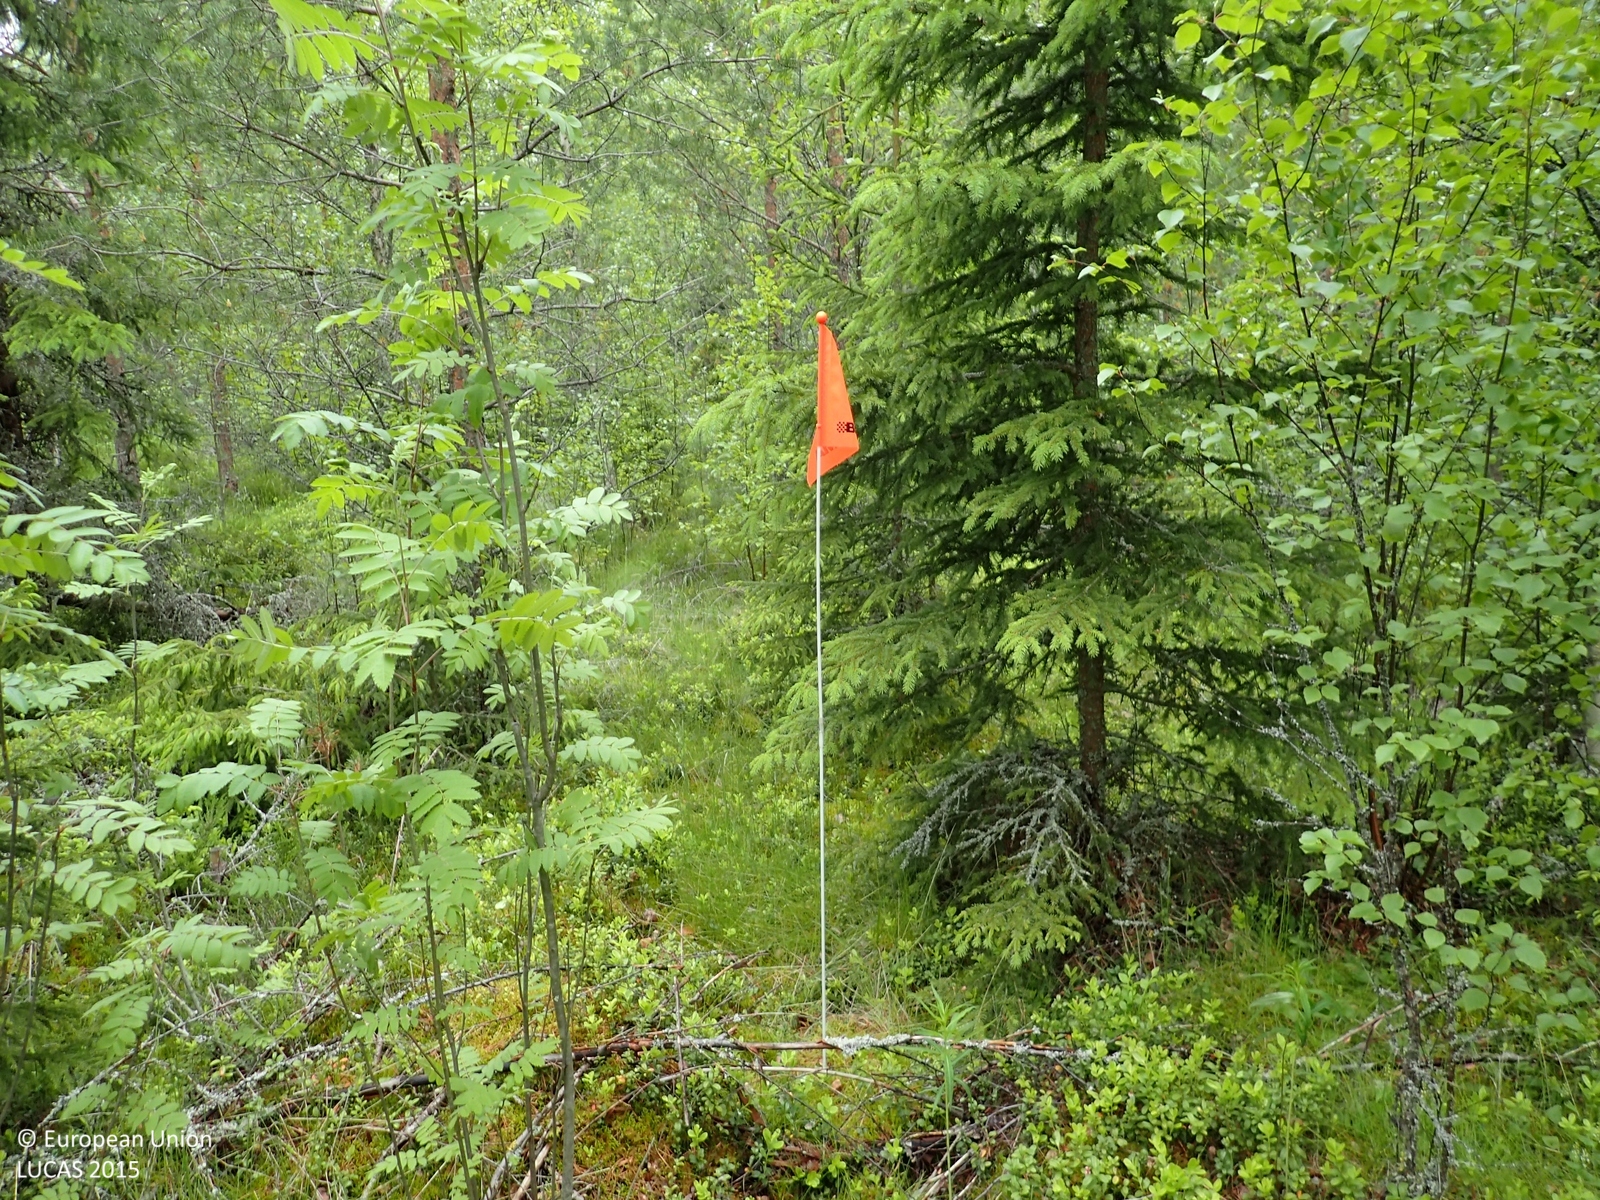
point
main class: Woodland
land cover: Pine dominated coniferous woodland
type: boreal forest
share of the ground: > 75 %
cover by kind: coniferous forest trees 70 %, shrubs 25 %, broadleaved forest trees 5 %
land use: Forestry
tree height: > 5 m
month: June
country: FI
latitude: 62.3528
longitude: 21.7342
